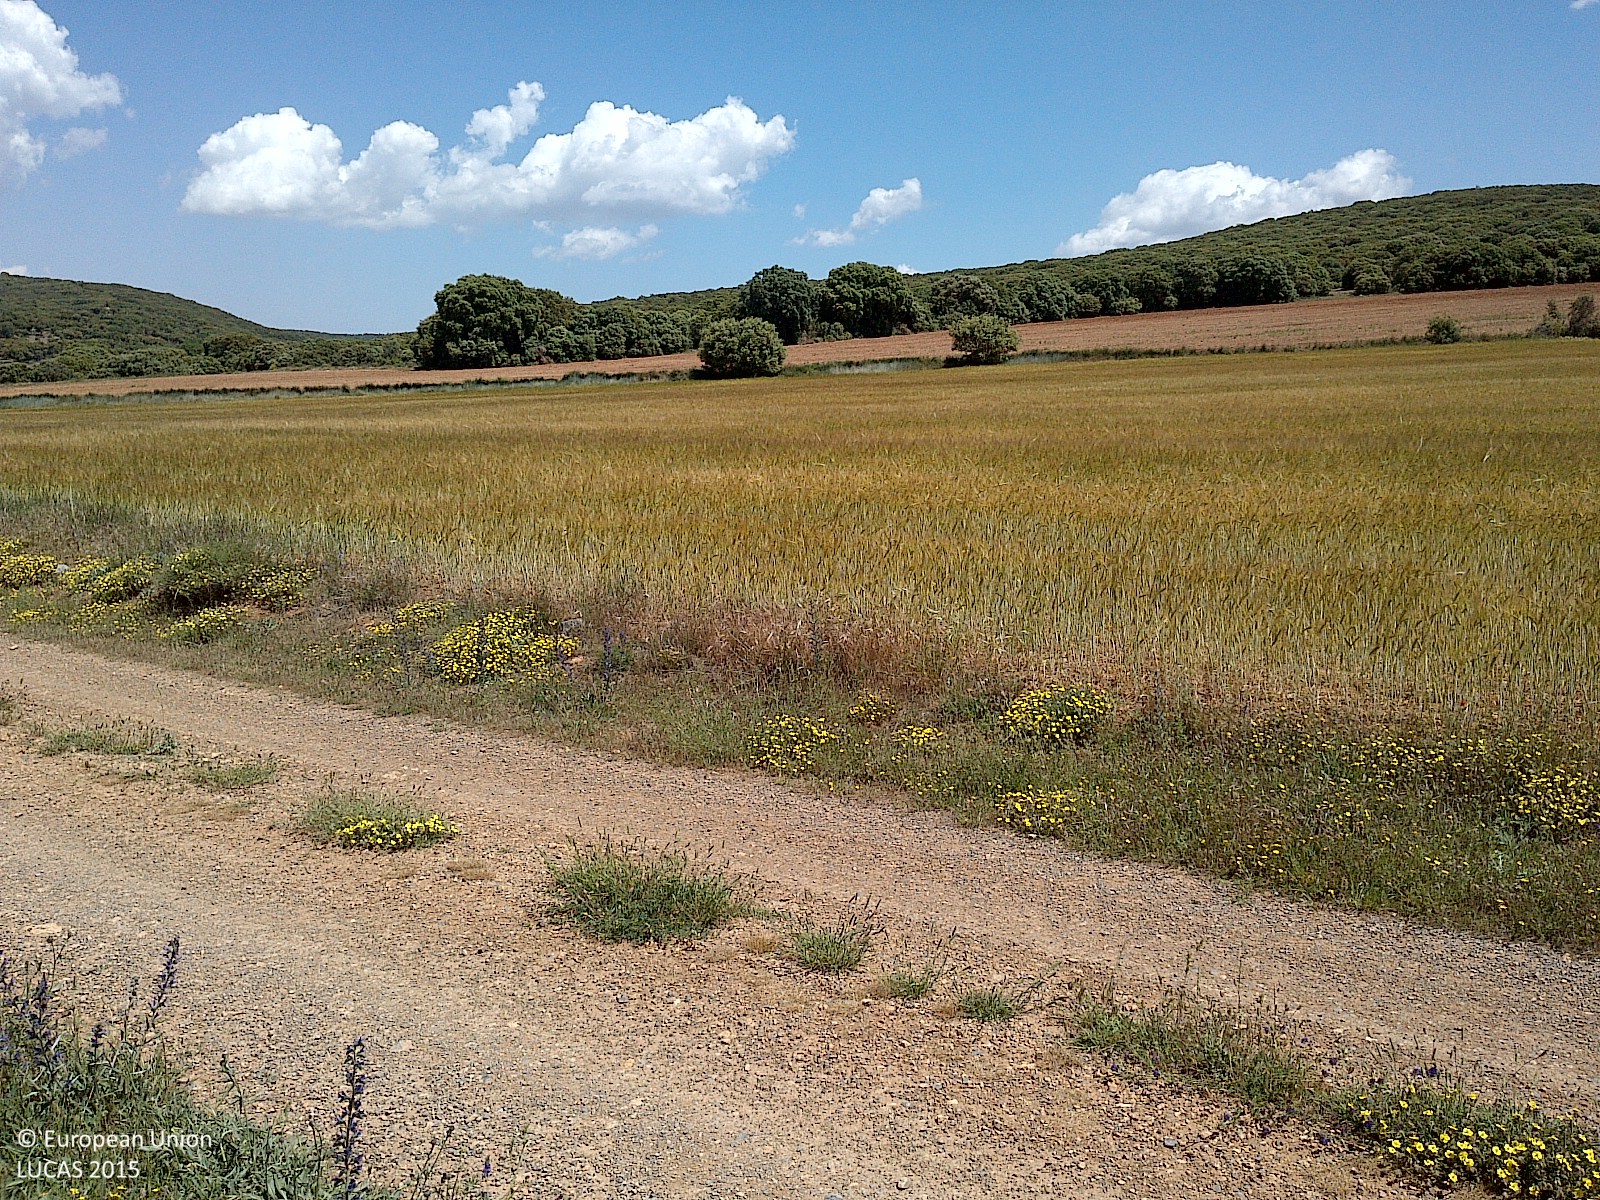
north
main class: Cropland
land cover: Barley
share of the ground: > 75 %
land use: Agriculture (excluding fallow land and kitchen gardens)
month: June
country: ES
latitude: 41.7647
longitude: -2.0743
